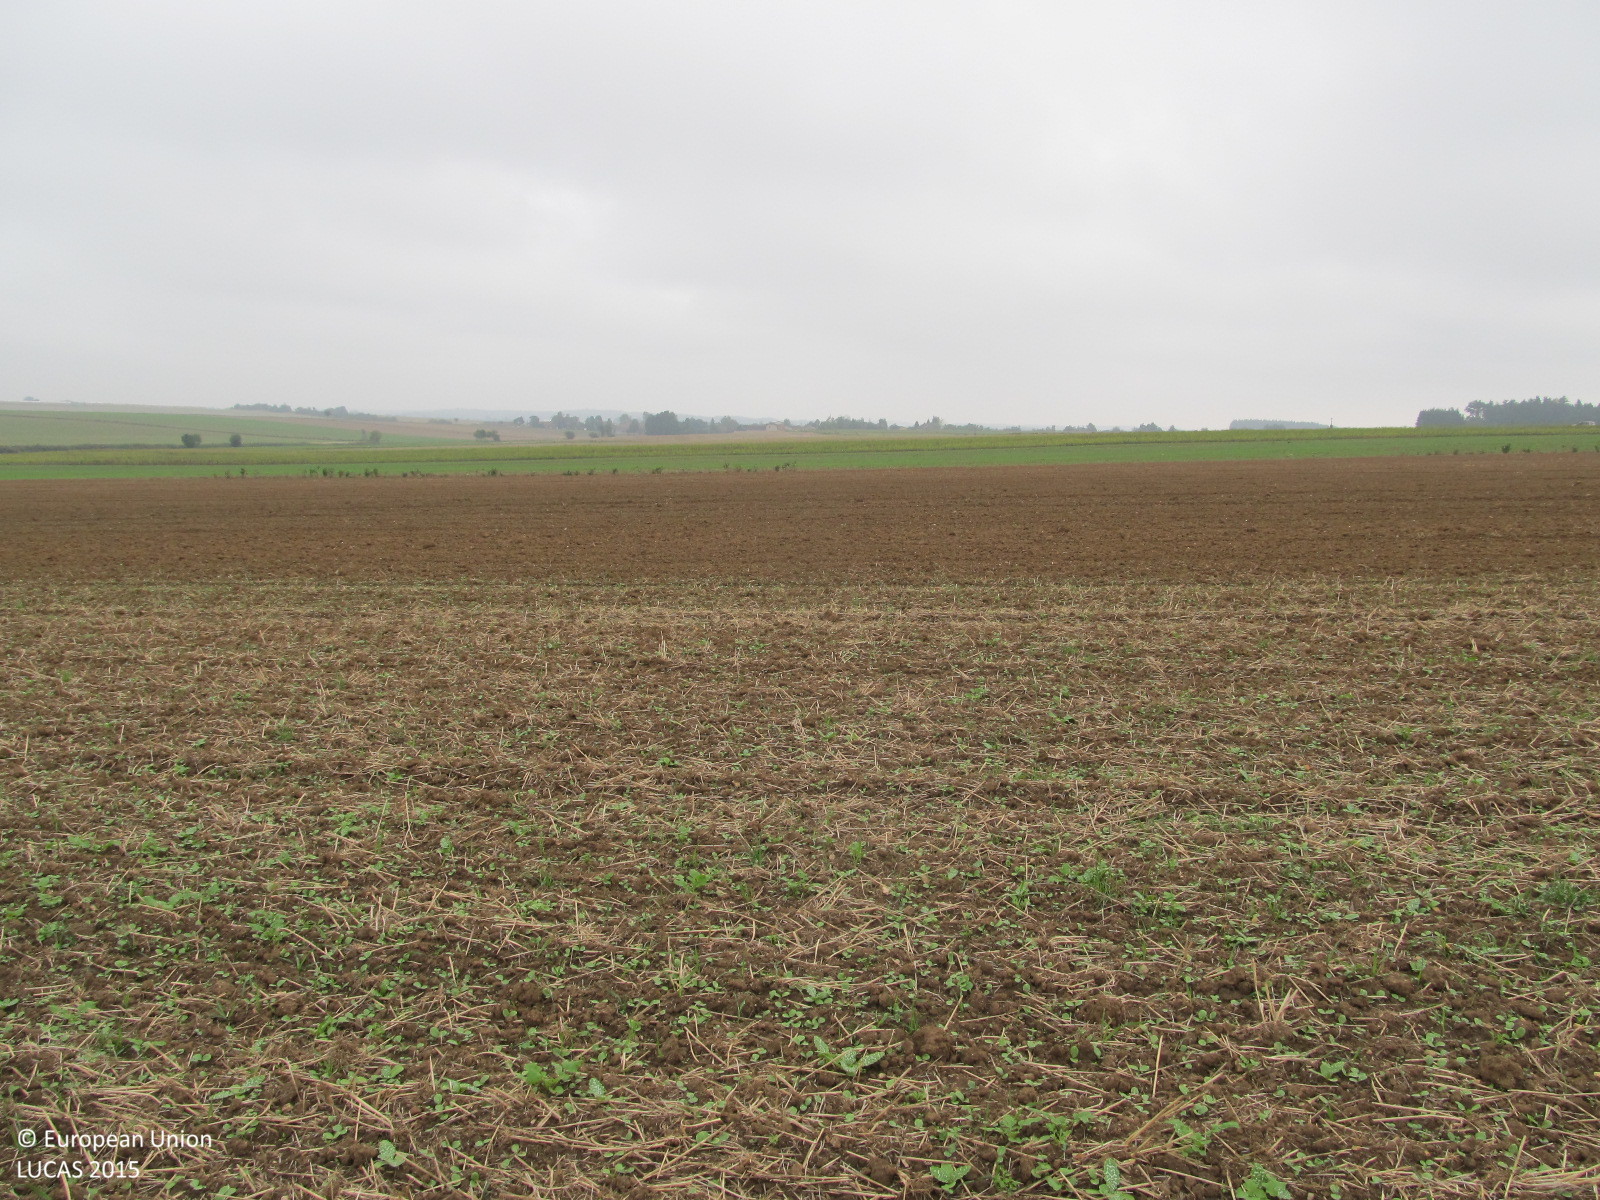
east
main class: Cropland
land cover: Common wheat
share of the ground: 25 - 50 %
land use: Agriculture (excluding fallow land and kitchen gardens)
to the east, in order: Common wheat; Grass margins; Other bare soil; Mixed cereals for fodder
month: September
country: AT
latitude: 48.8951
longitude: 15.5549
